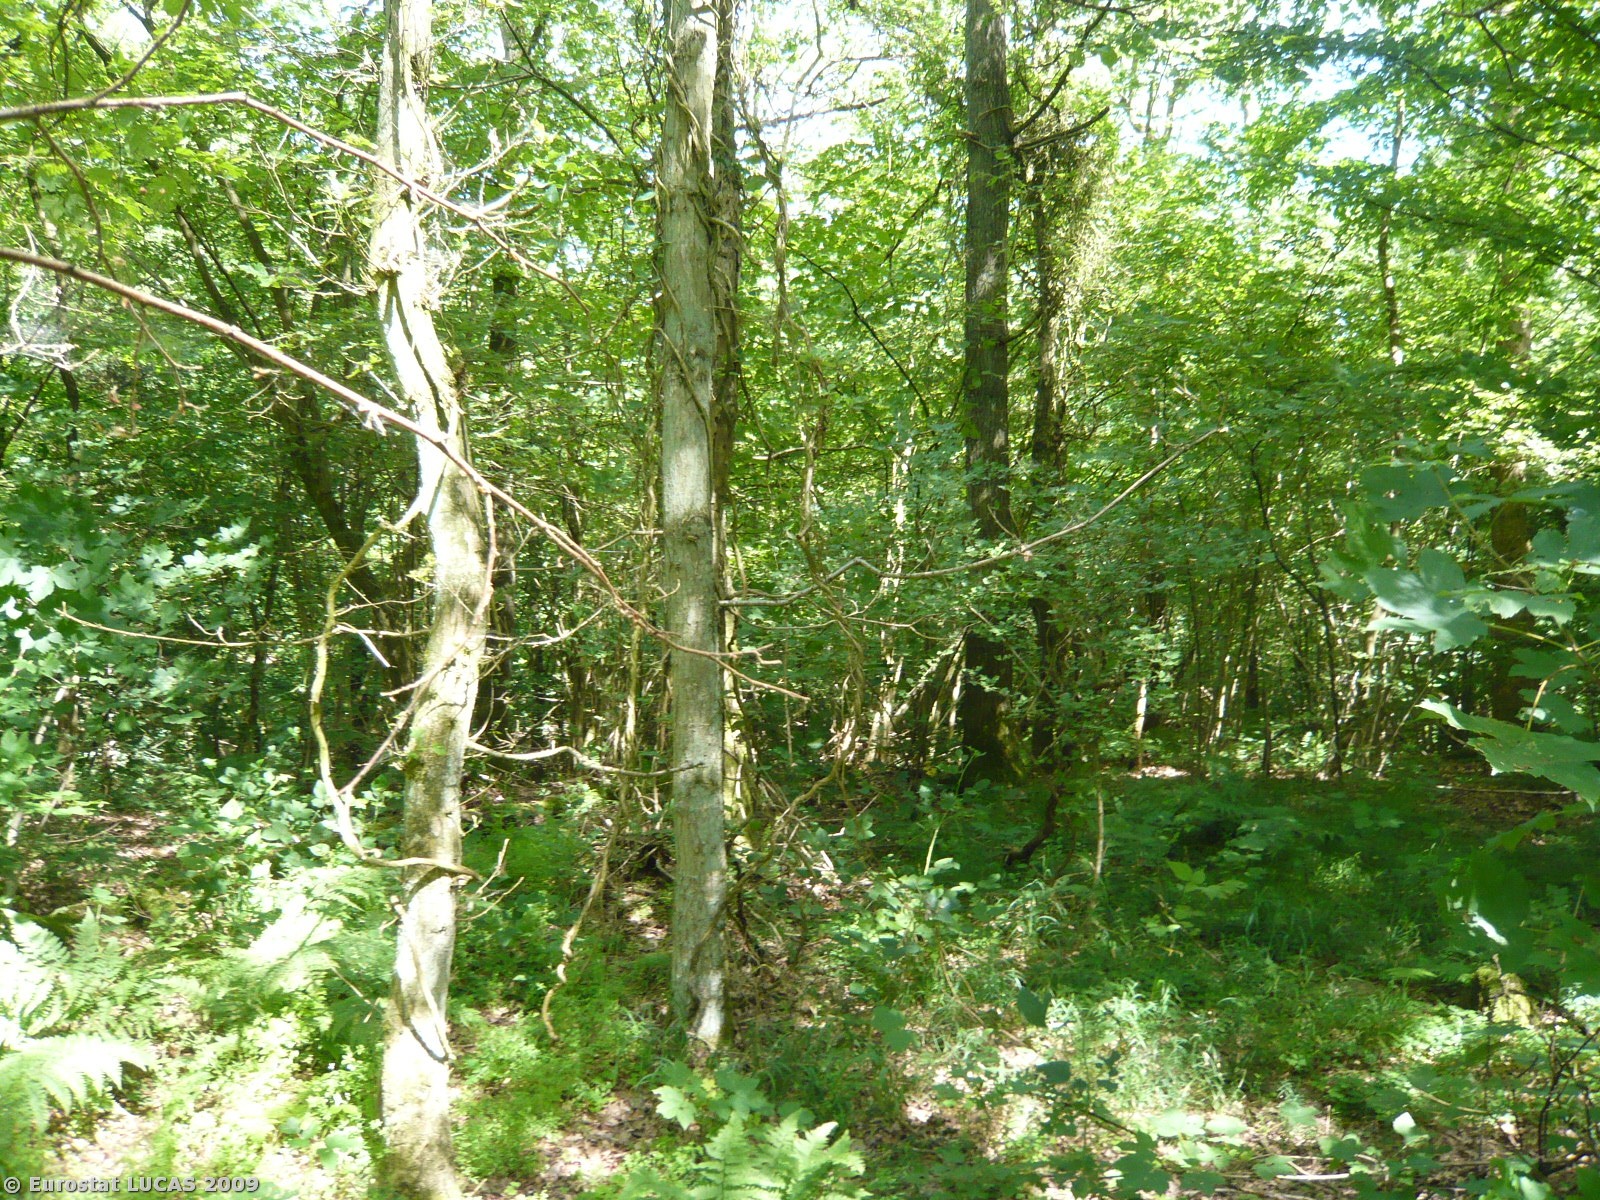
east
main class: Woodland
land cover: Broadleaved woodland
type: mesophytic deciduous forest
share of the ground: > 75 %
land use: Amenities, museums, leisure
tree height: > 5 m
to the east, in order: Broadleaved woodland
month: June
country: DK
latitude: 55.1450
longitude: 10.2665
